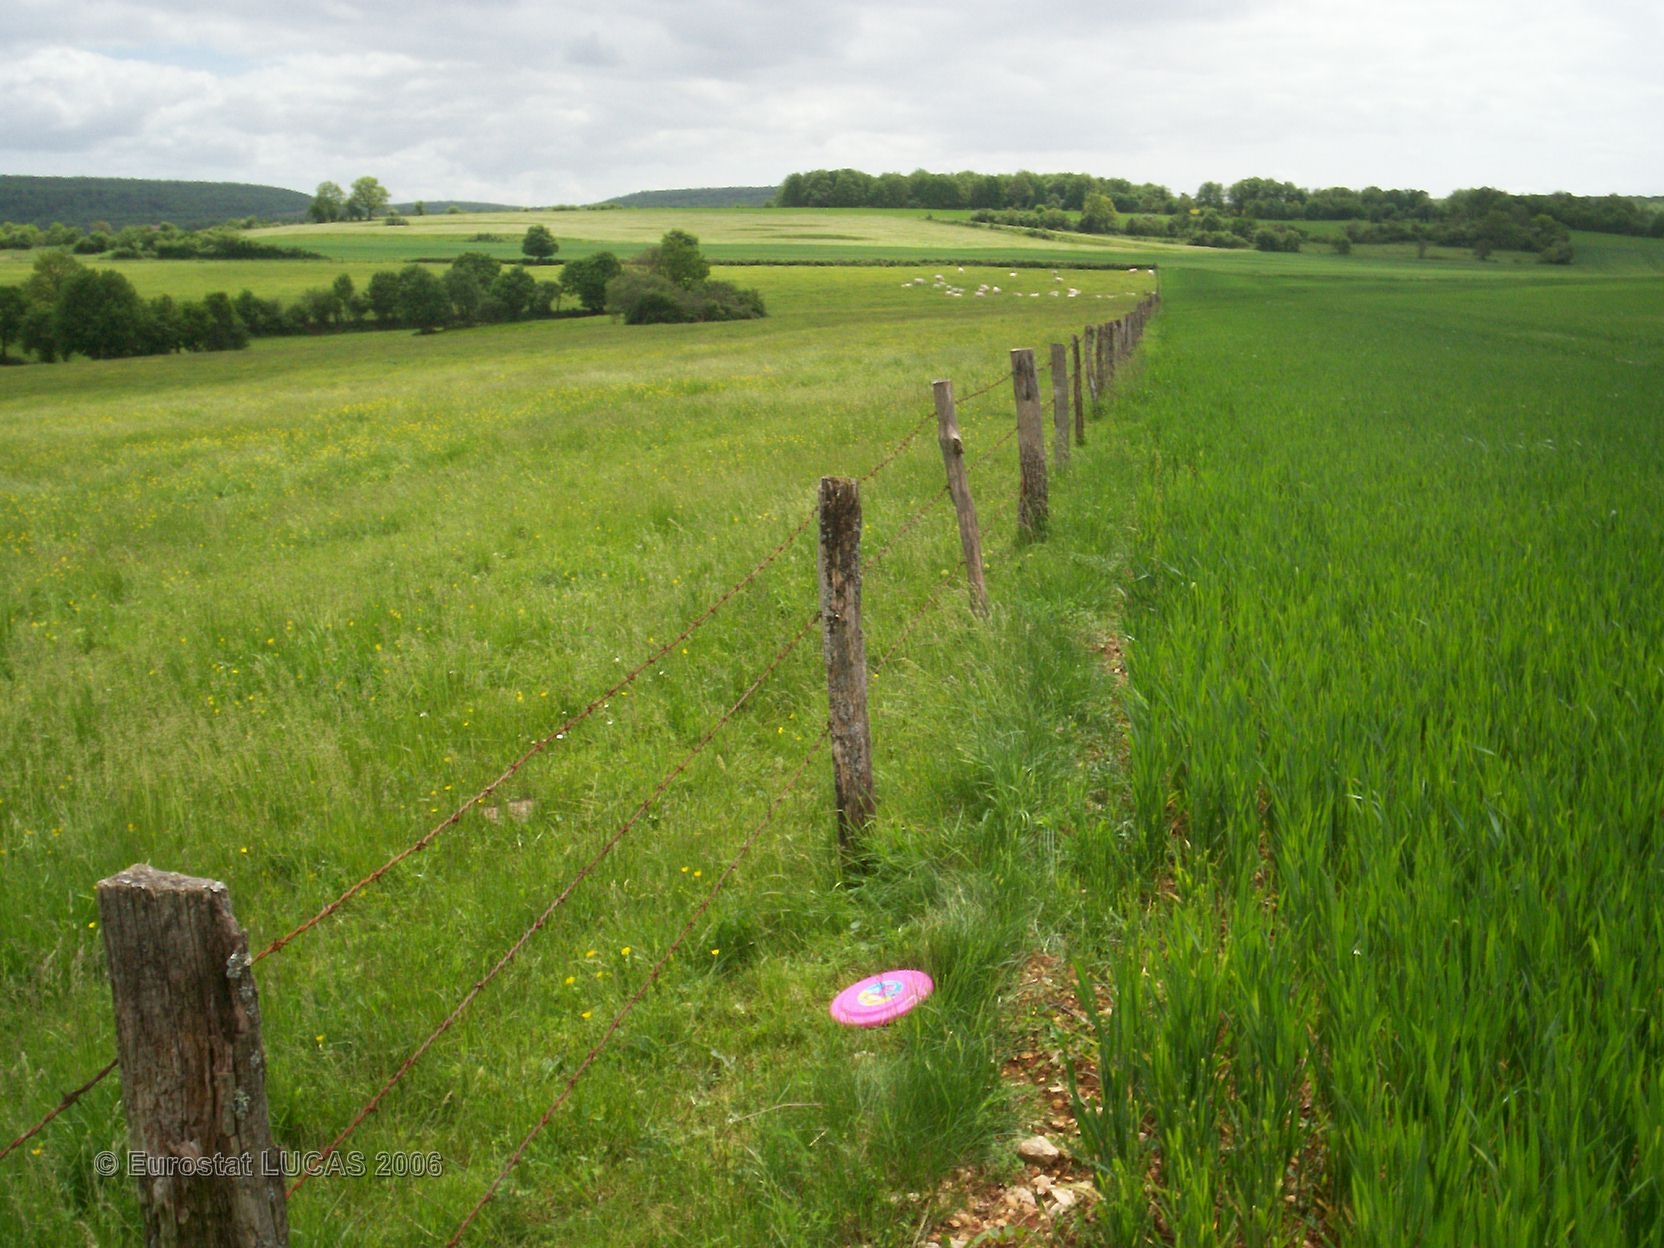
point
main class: Grassland
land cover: Grassland without tree/shrub cover
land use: Agriculture (excluding fallow land and kitchen gardens)
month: May
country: FR
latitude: 47.1574
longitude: 4.6847
